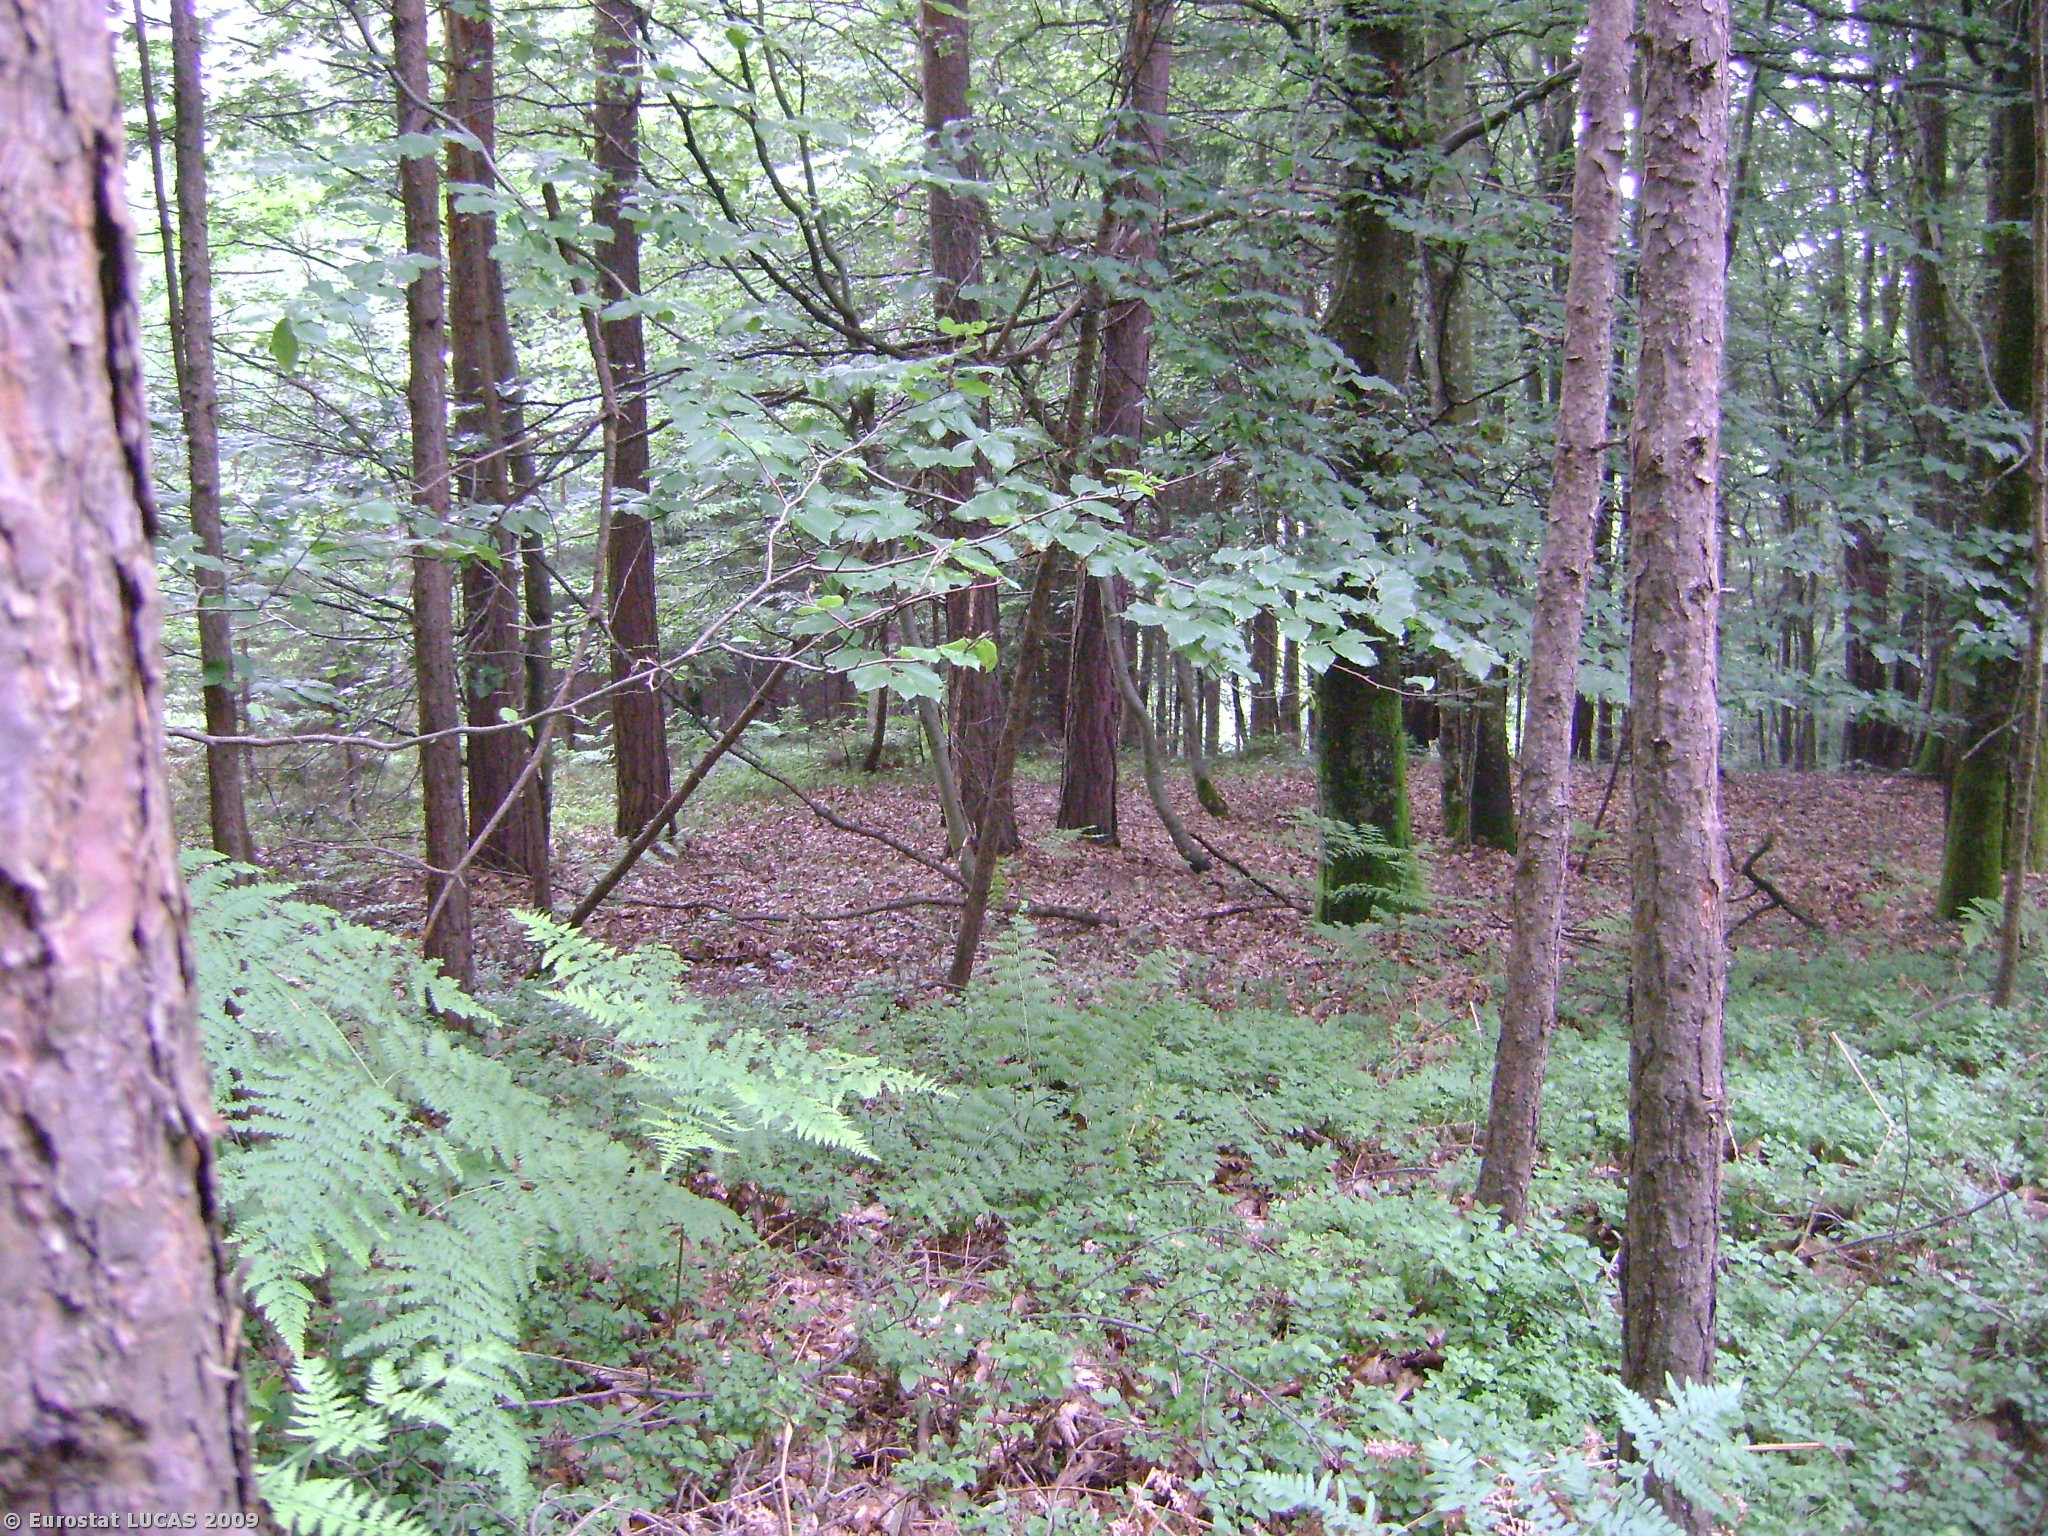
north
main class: Woodland
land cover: Broadleaved woodland
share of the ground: > 75 %
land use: Forestry
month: June
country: AT
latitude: 46.8668
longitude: 15.7066
